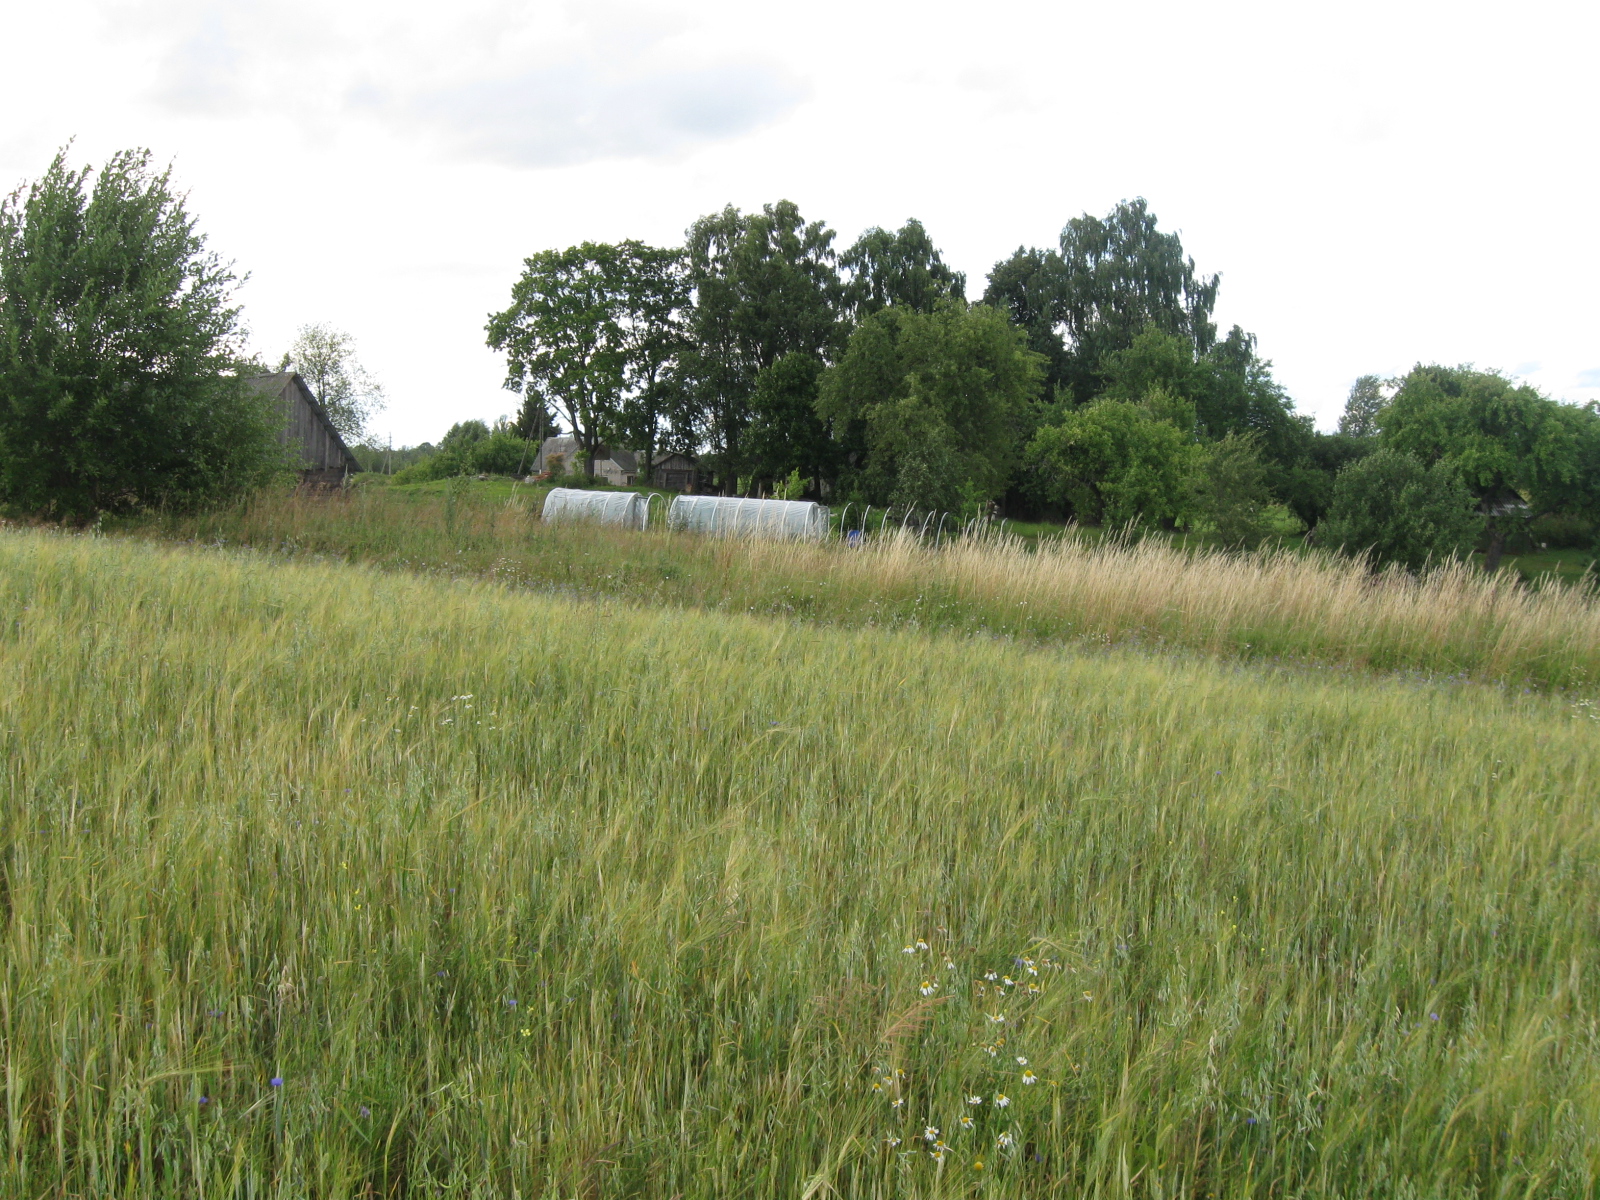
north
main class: Cropland
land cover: Barley
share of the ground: > 75 %
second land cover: Oats
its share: 10 - 25 %
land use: Agriculture (excluding fallow land and kitchen gardens)
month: July
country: LT
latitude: 54.3496
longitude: 24.3621
